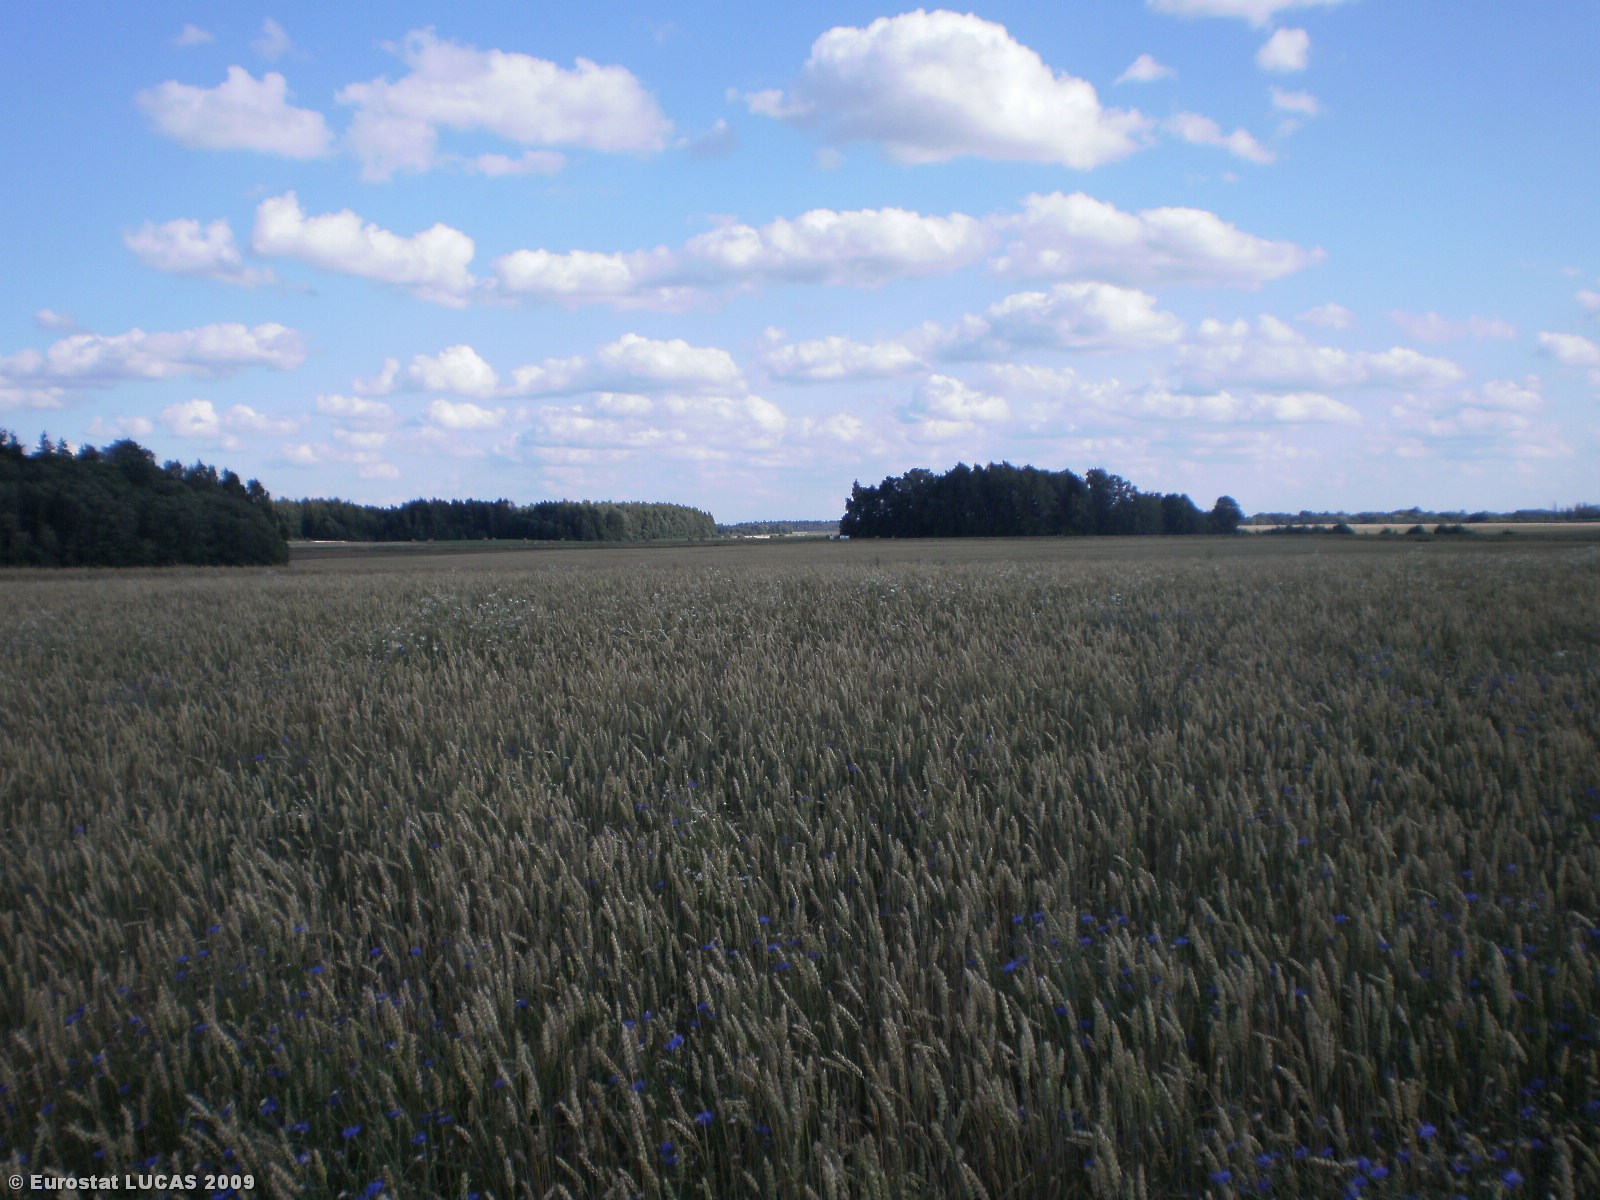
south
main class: Cropland
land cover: Common wheat
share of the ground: > 75 %
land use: Agriculture (excluding fallow land and kitchen gardens)
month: July
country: LT
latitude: 55.8396
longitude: 25.0749
